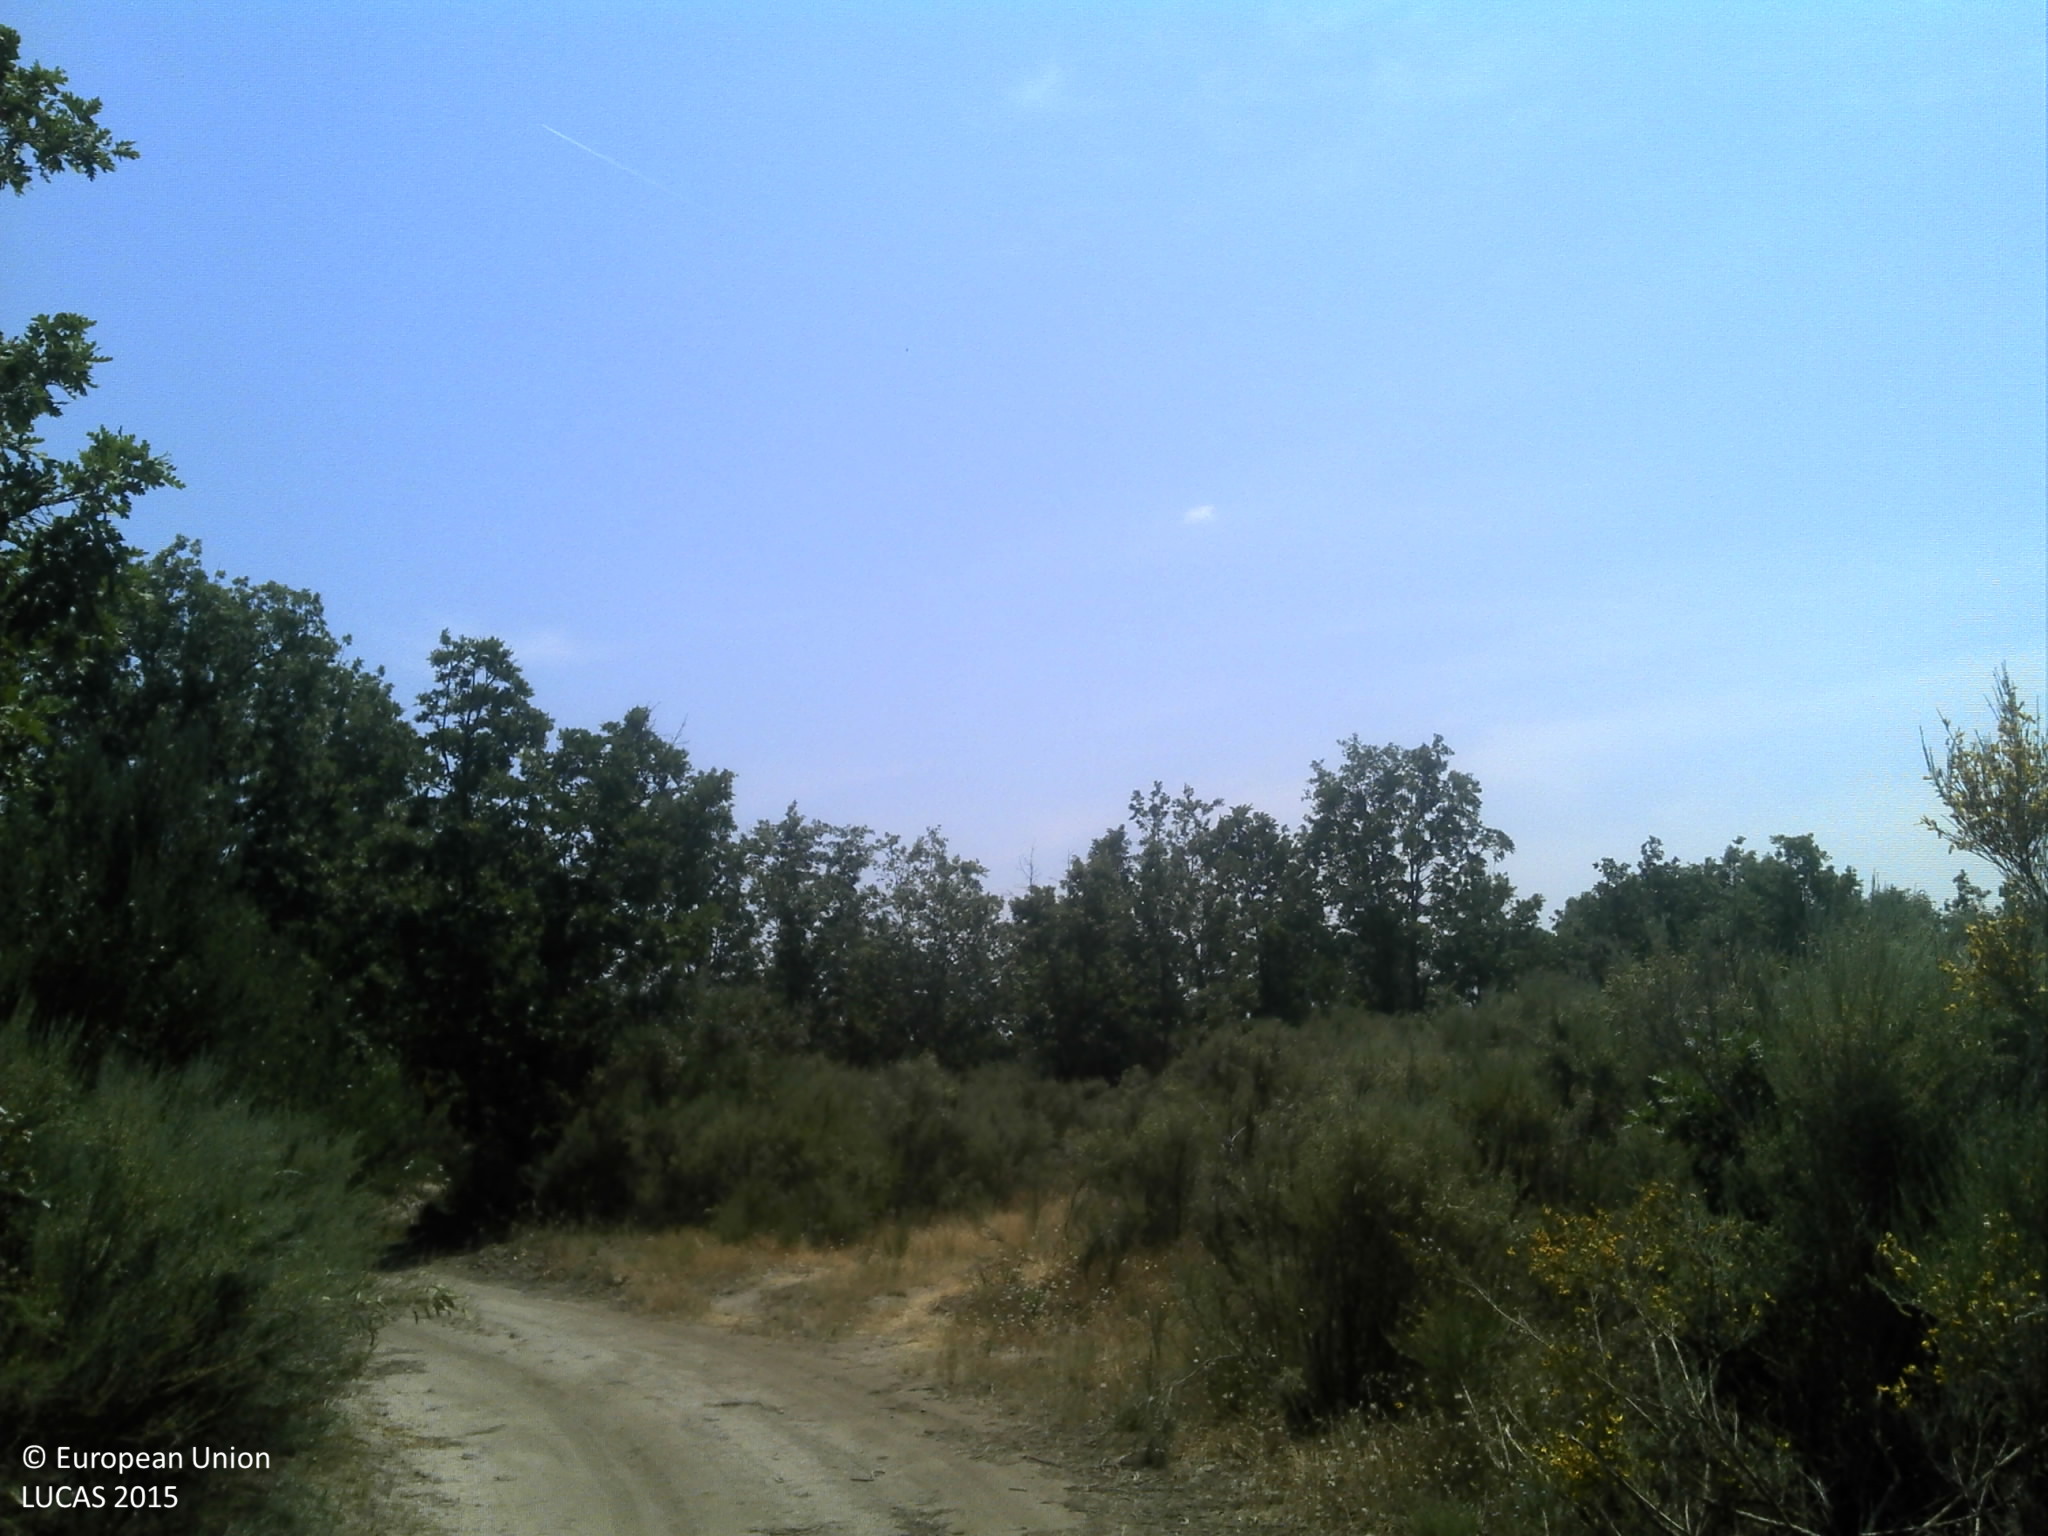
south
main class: Shrubland
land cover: Shrubland with sparse tree cover
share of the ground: 50 - 75 %
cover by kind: shrubs 70 %, unconsolidated bare surface 10 %, broadleaved forest trees 5 %, herbaceous plants 5 %
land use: Forestry
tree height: > 5 m
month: June
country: PT
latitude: 40.3646
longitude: -6.8506
